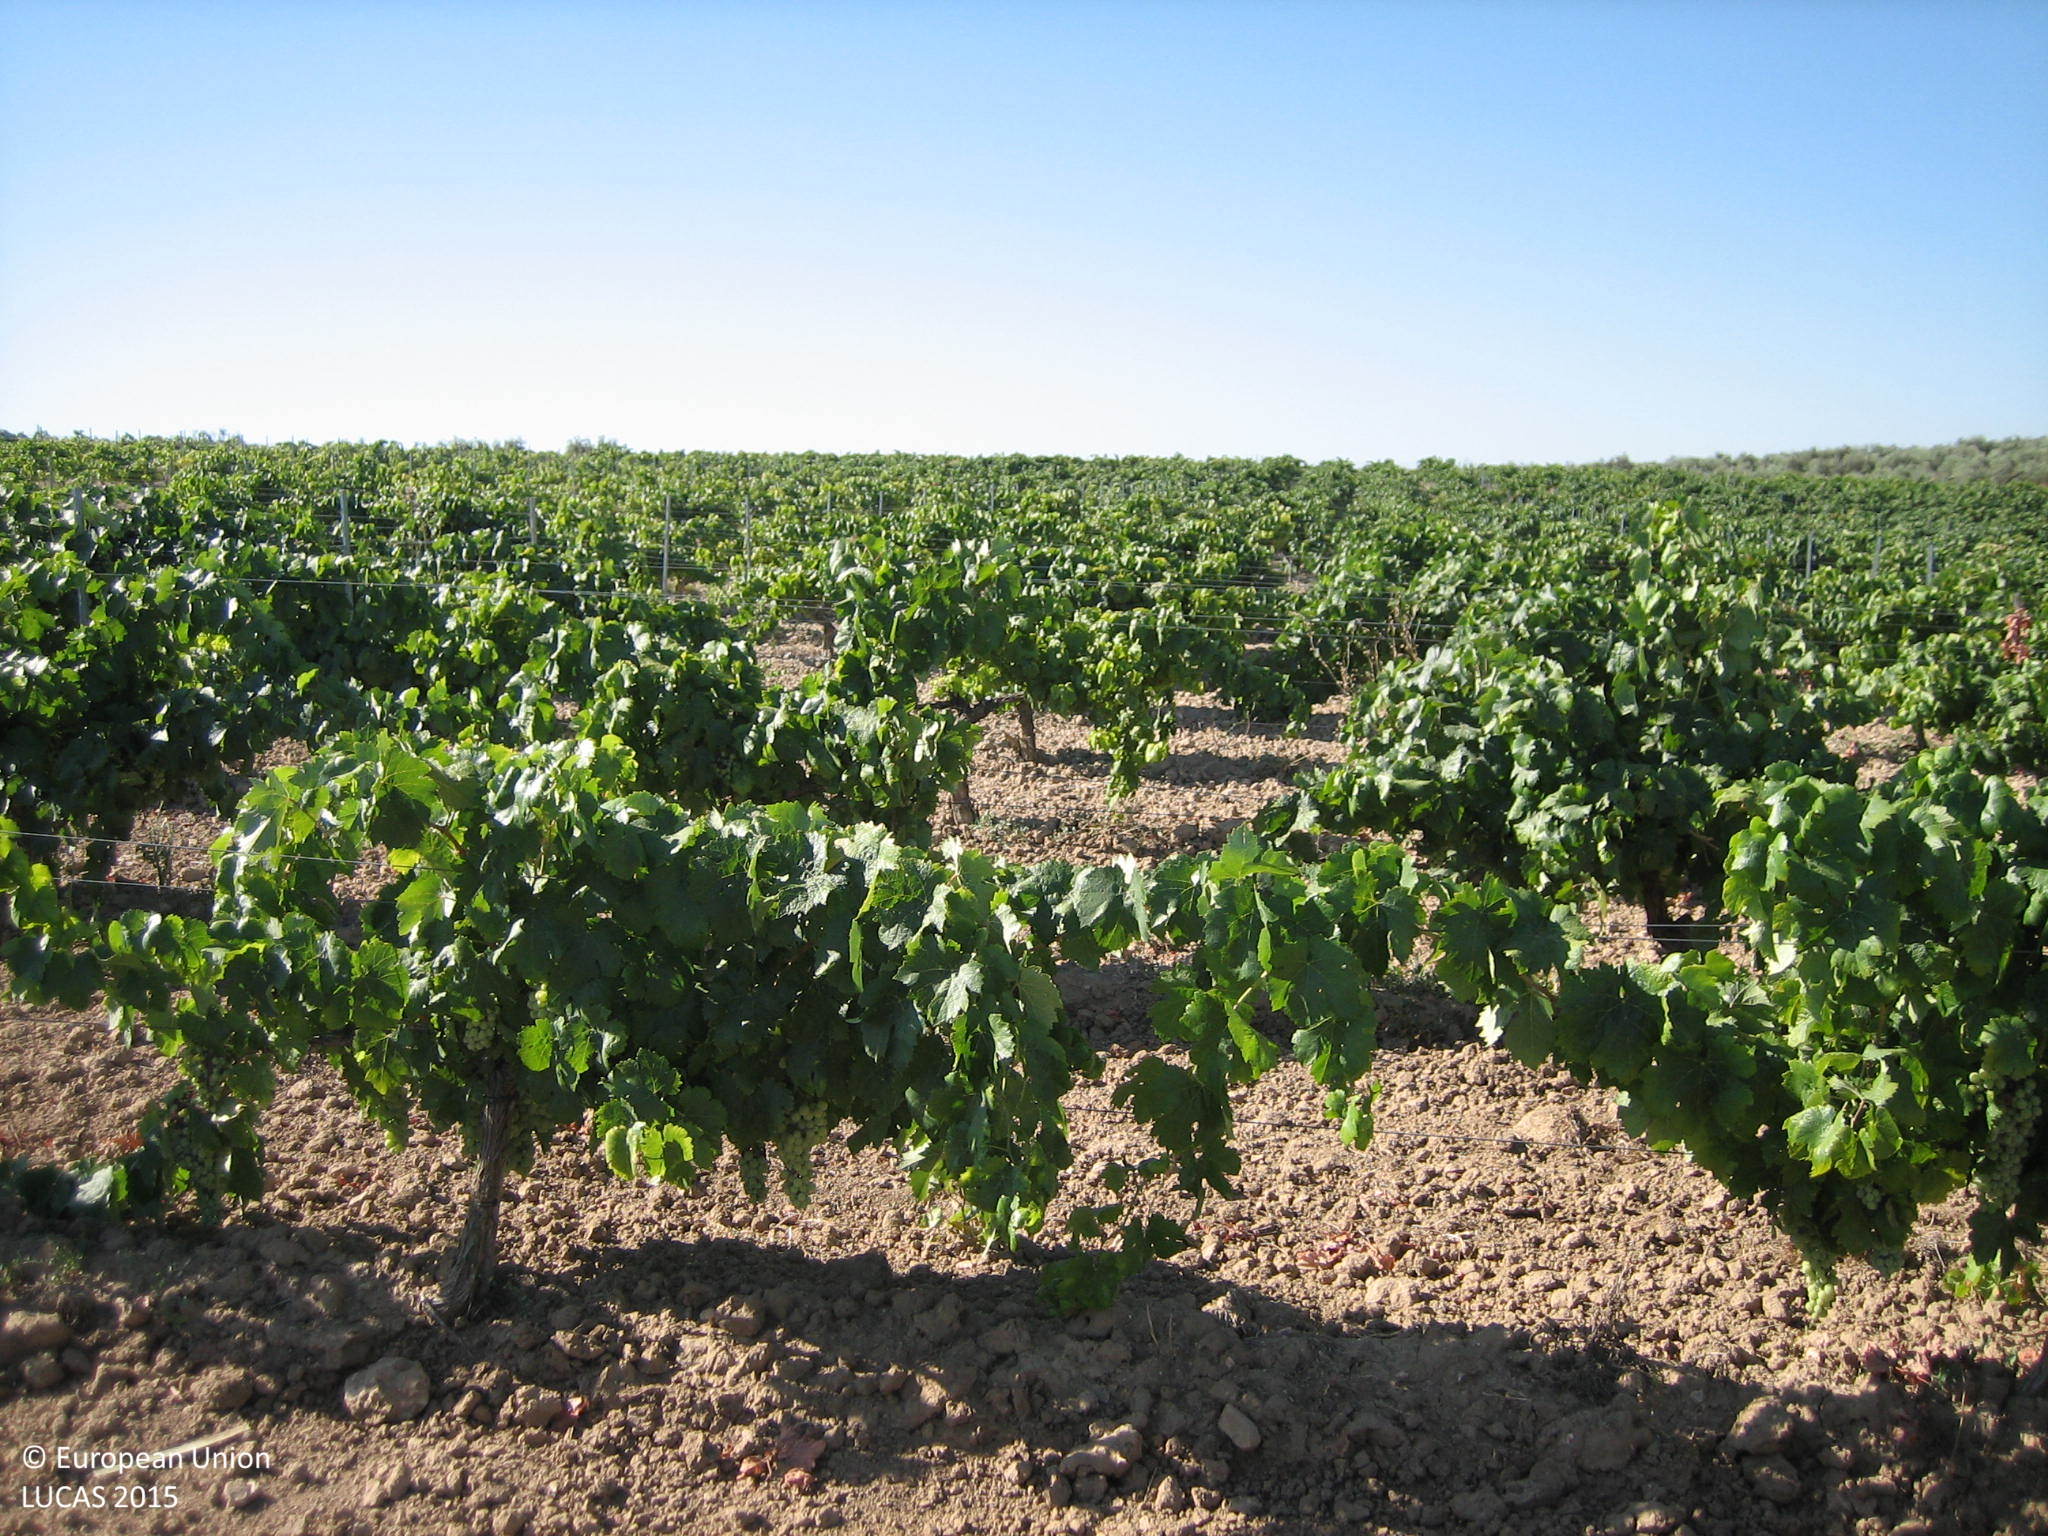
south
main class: Cropland
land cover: Vineyards
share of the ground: 25 - 50 %
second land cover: Other bare soil
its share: > 75 %
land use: Agriculture (excluding fallow land and kitchen gardens)
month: July
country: ES
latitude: 38.4817
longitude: -6.3395
